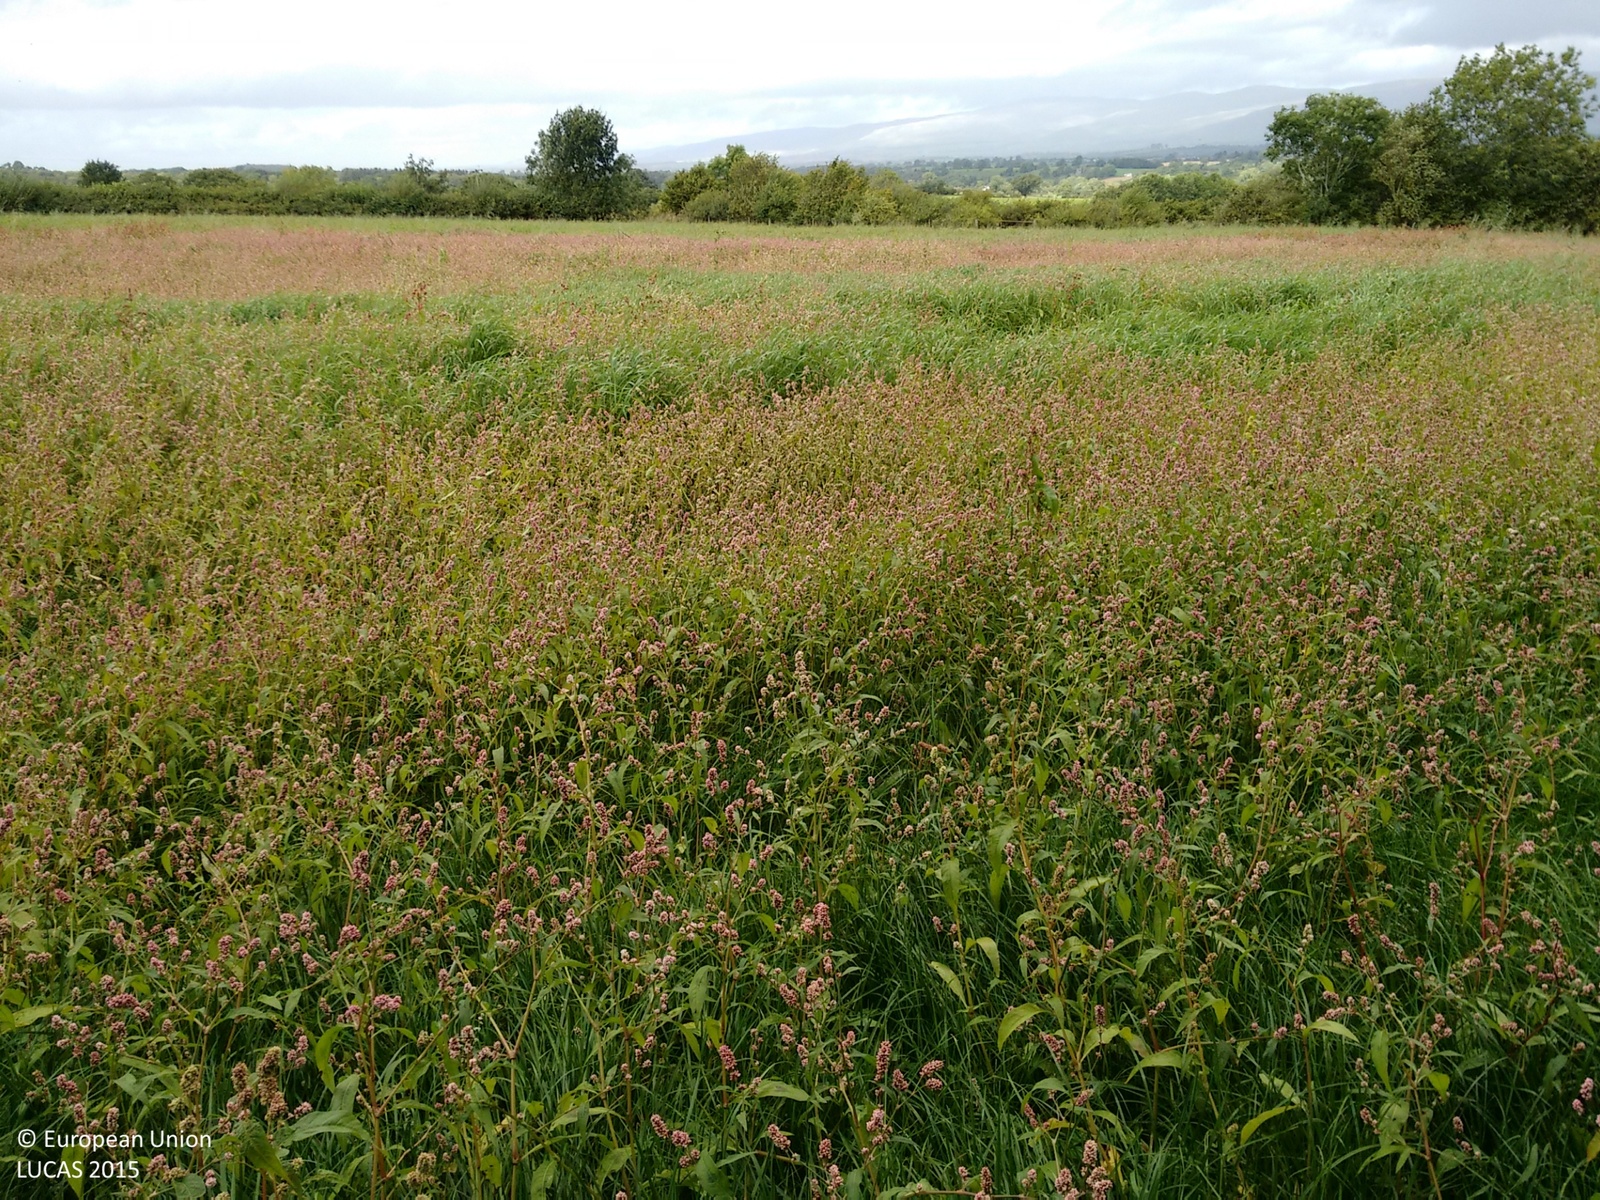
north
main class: Grassland
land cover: Grassland without tree/shrub cover
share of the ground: > 75 %
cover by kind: herbaceous plants 100 %
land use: Agriculture (excluding fallow land and kitchen gardens)
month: September
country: GB
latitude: 54.5348
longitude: -2.5047
